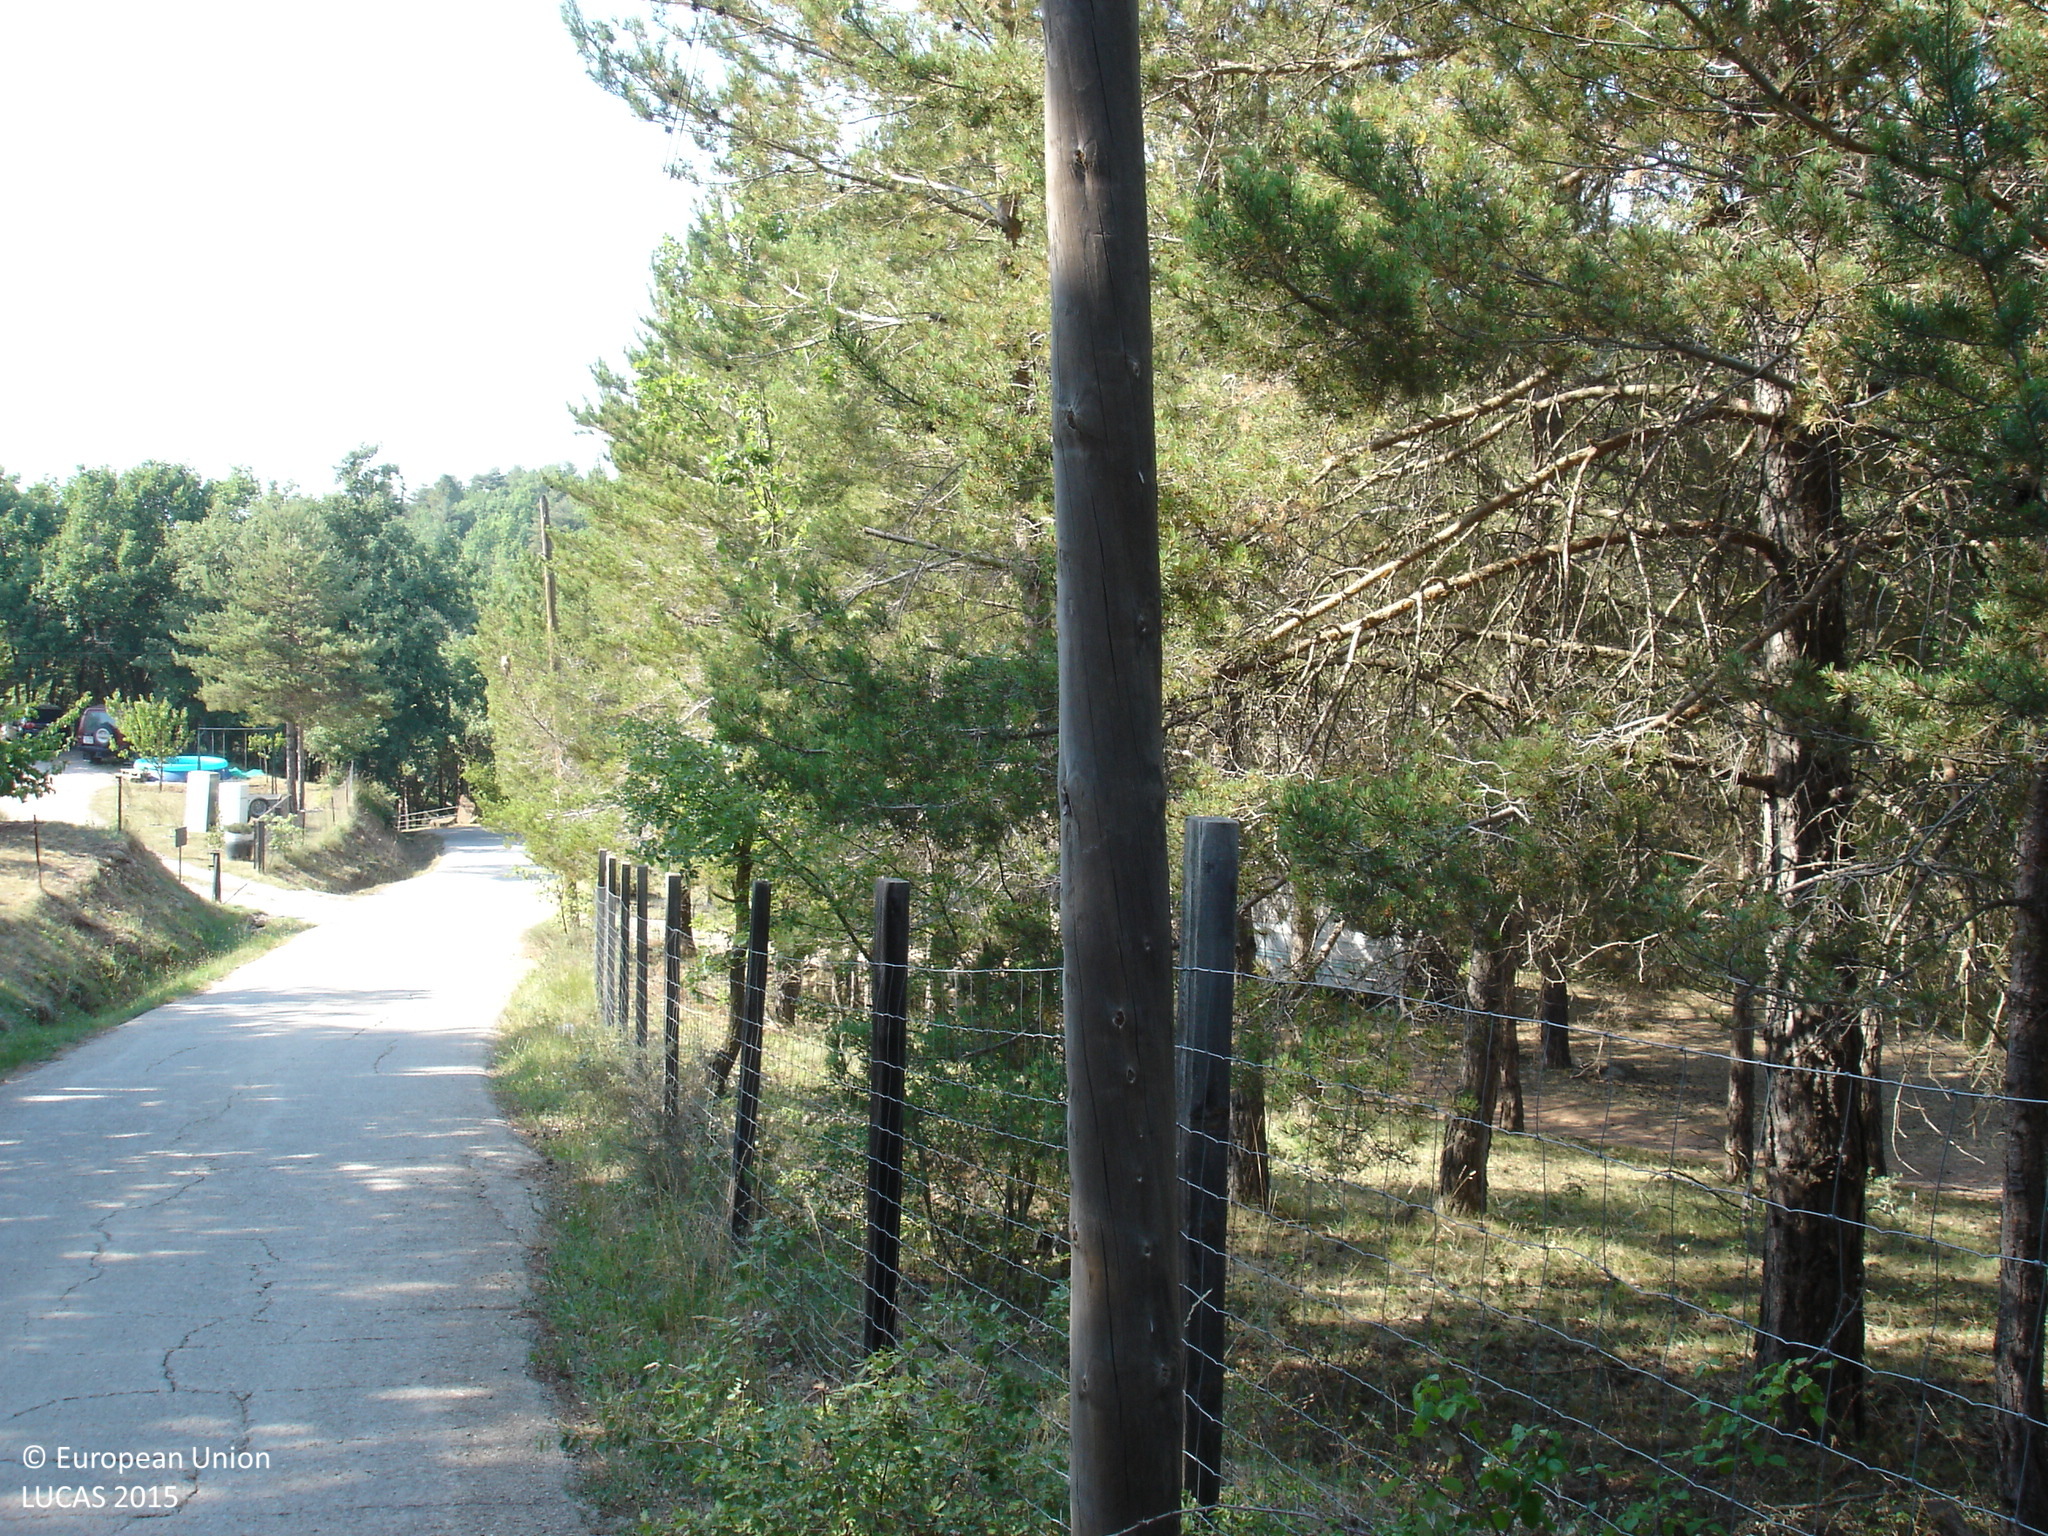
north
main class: Woodland
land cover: Other mixed woodland
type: thermophilous deciduous forest
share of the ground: 25 - 50 %
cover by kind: herbaceous plants 50 %, broadleaved forest trees 30 %, coniferous forest trees 10 %, shrubs 5 %
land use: Forestry
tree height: > 5 m
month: July
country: ES
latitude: 41.8610
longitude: 2.1728
